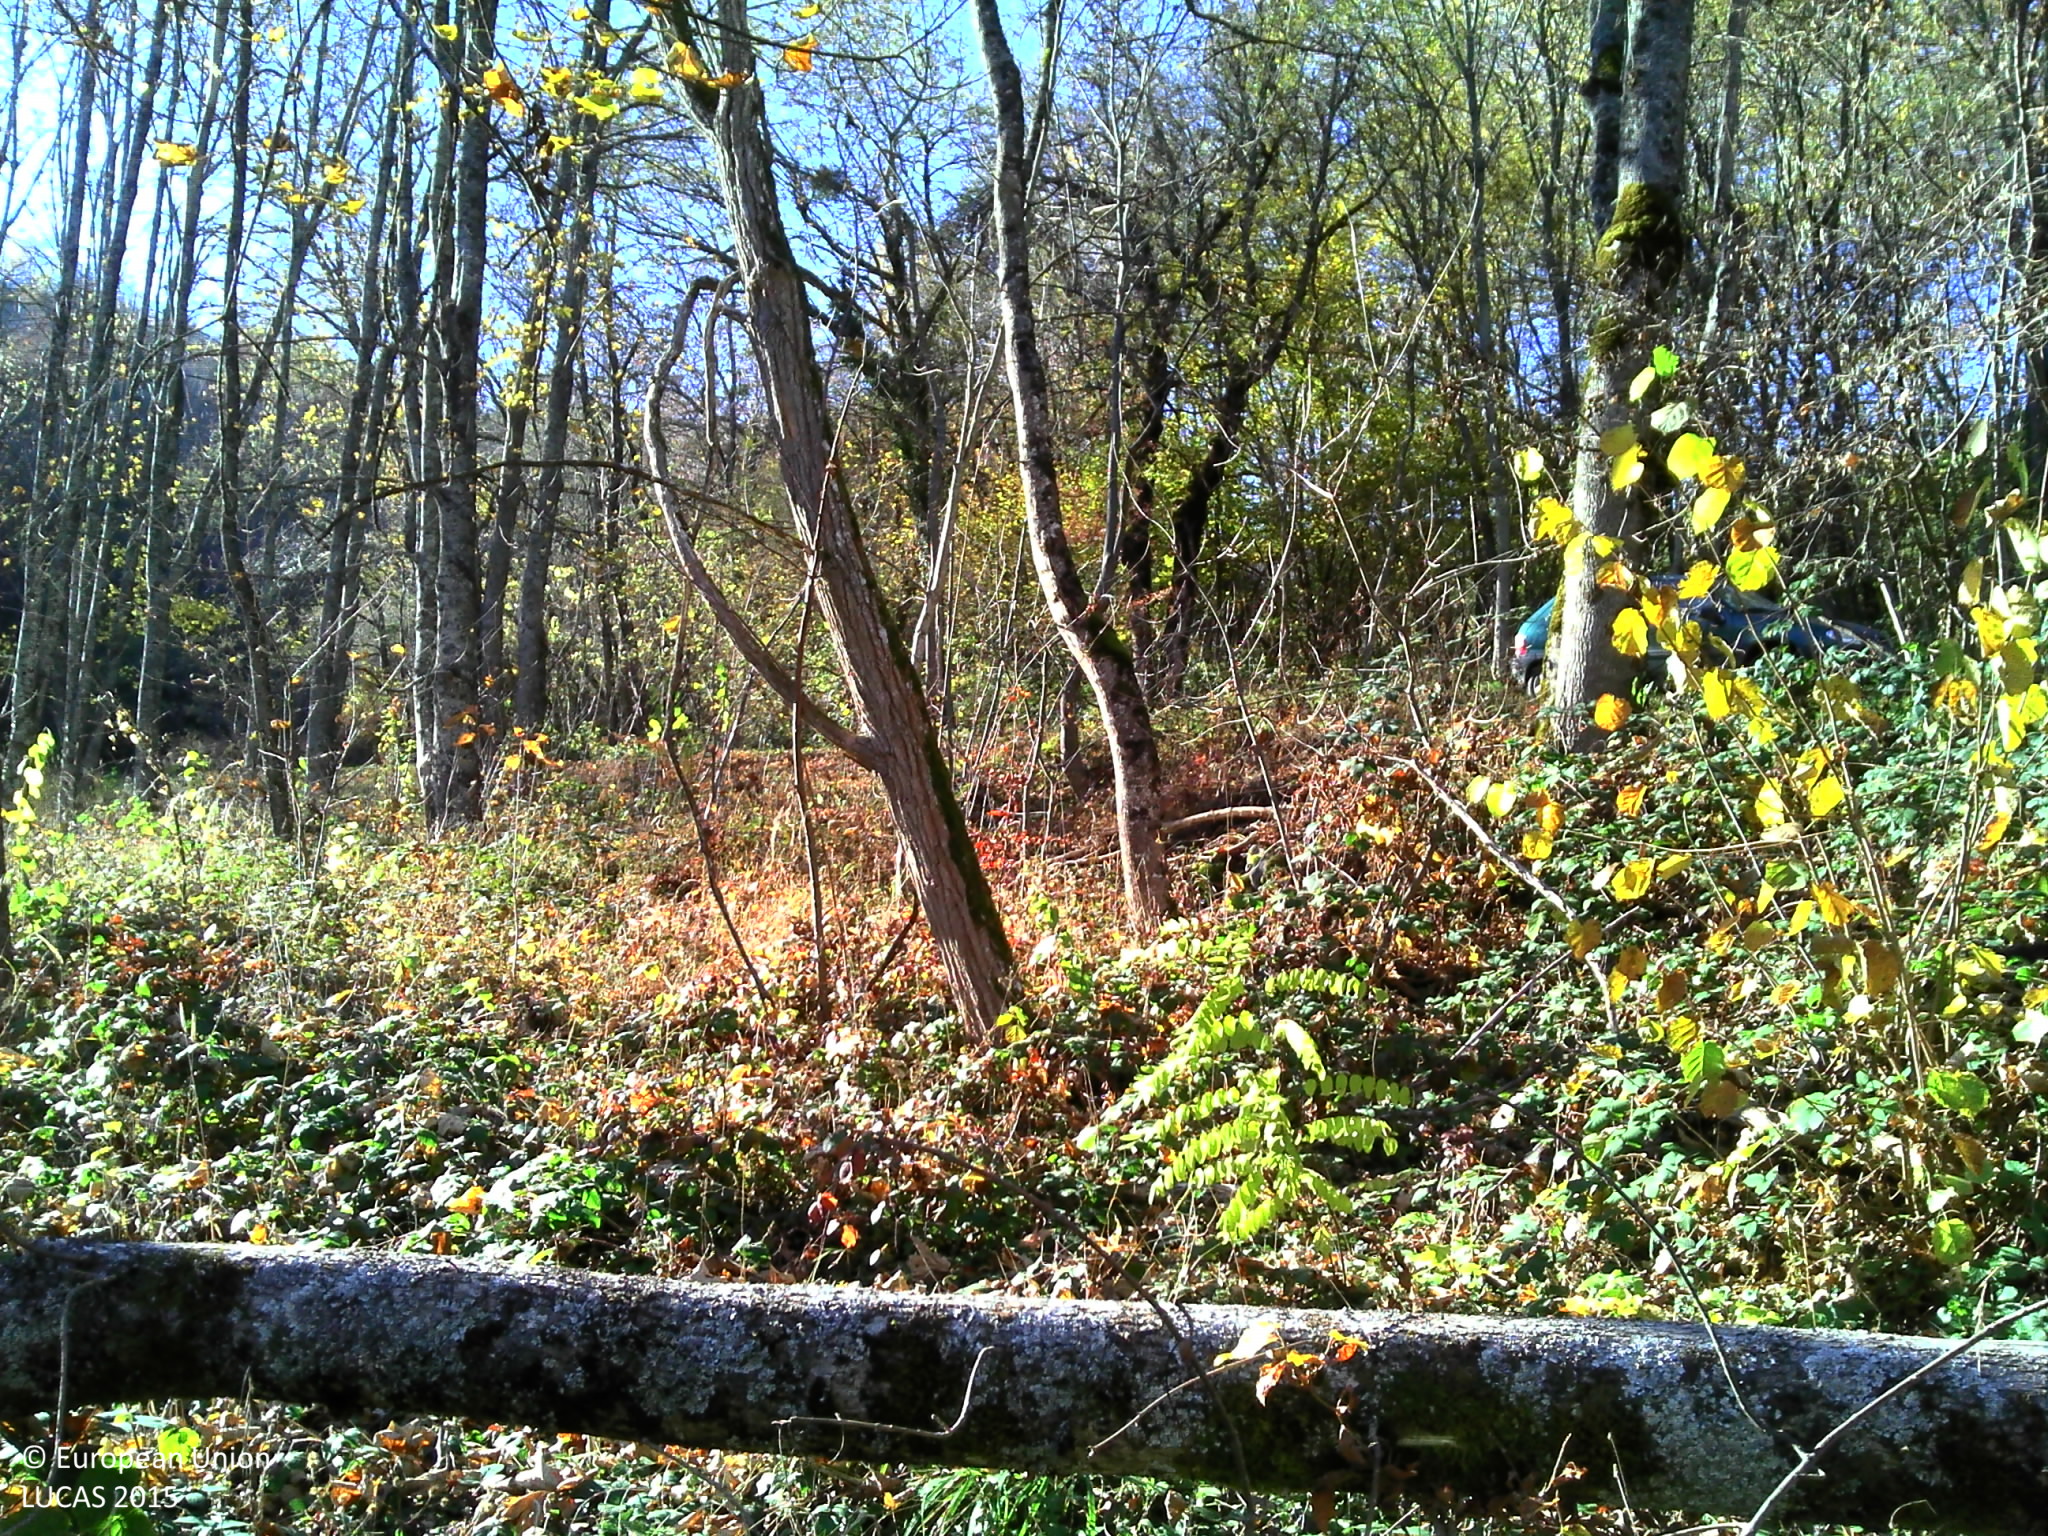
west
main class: Woodland
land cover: Broadleaved woodland
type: mesophytic deciduous forest
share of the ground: 50 - 75 %
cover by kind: broadleaved forest trees 45 %, shrubs 45 %, herbaceous plants 10 %
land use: Forestry
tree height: > 5 m
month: November
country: FR
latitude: 45.6748
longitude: 6.3200
